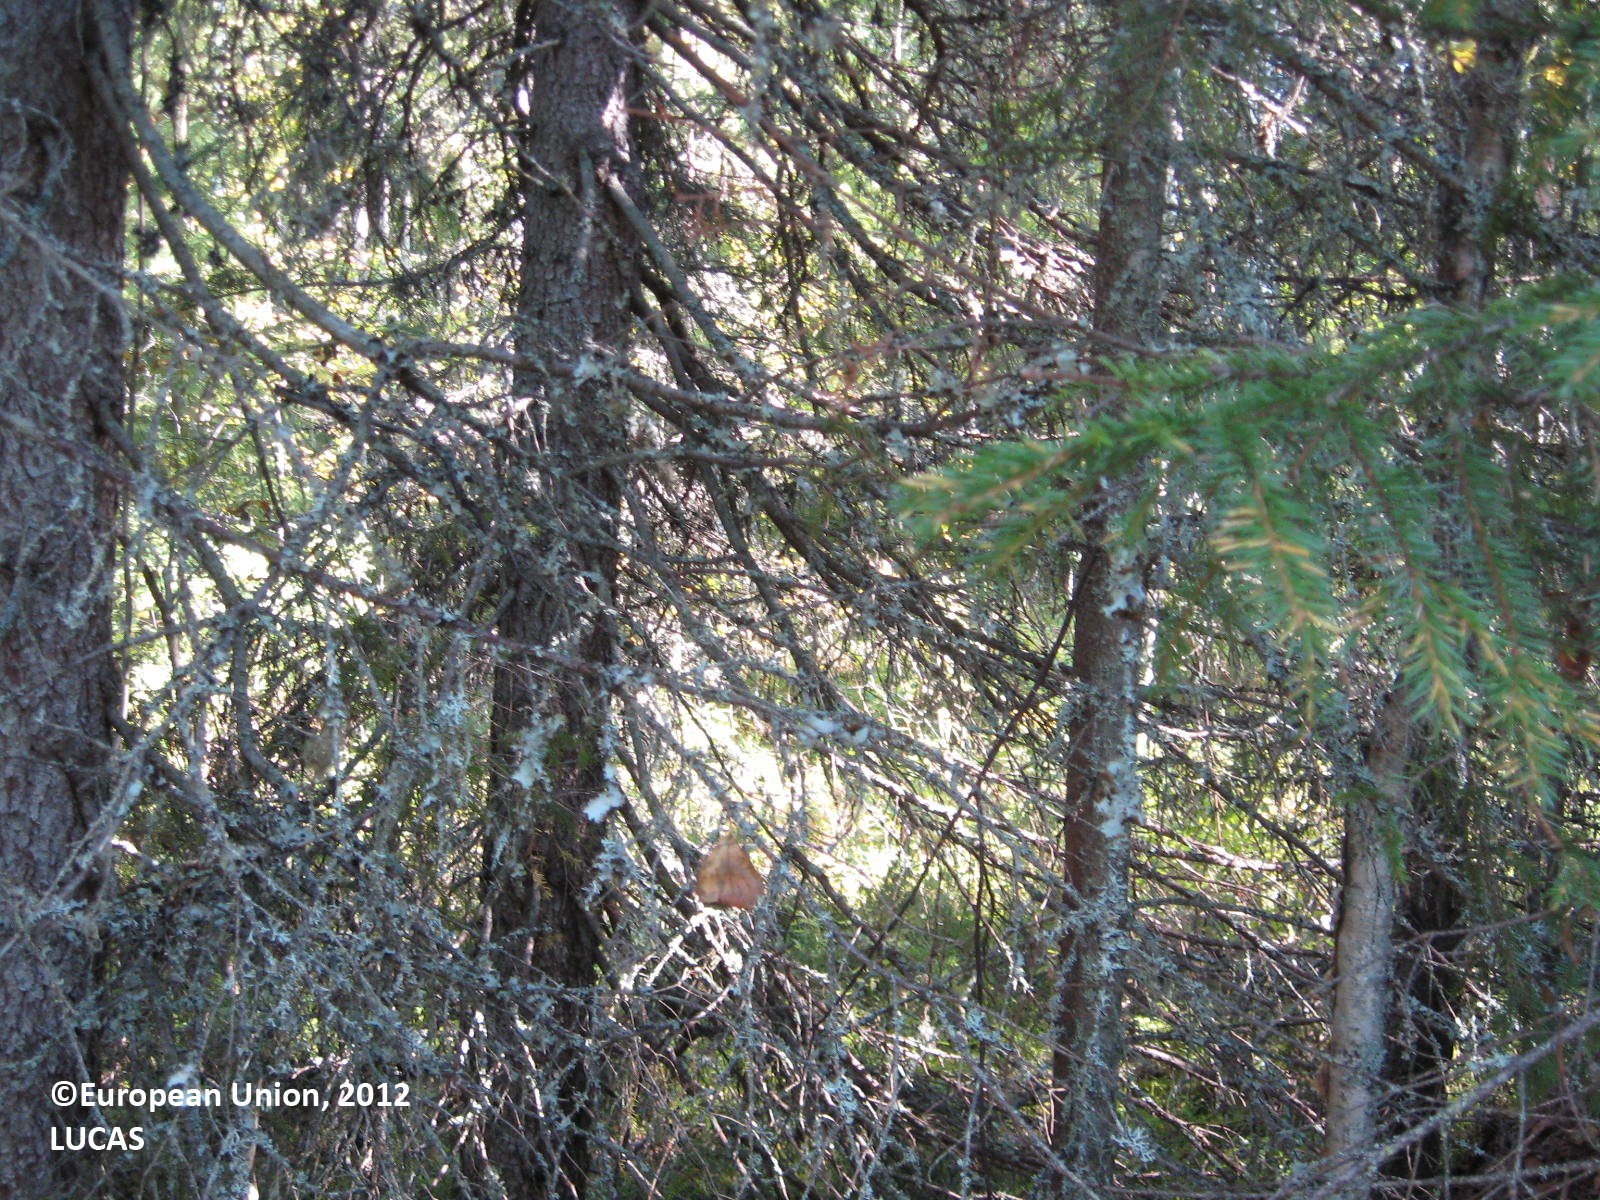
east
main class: Woodland
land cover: Spruce dominated coniferous woodland
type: boreal forest
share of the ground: > 75 %
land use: Forestry
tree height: > 5 m
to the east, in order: Spruce dominated coniferous woodland; Pine dominated mixed woodland; Tracks; Pine dominated mixed woodland; Shruby margins; Ditches and canals; Shruby margins; Grass margins; Paved roads, cycling and walking lanes
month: August
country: FI
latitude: 63.7984
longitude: 29.4026
